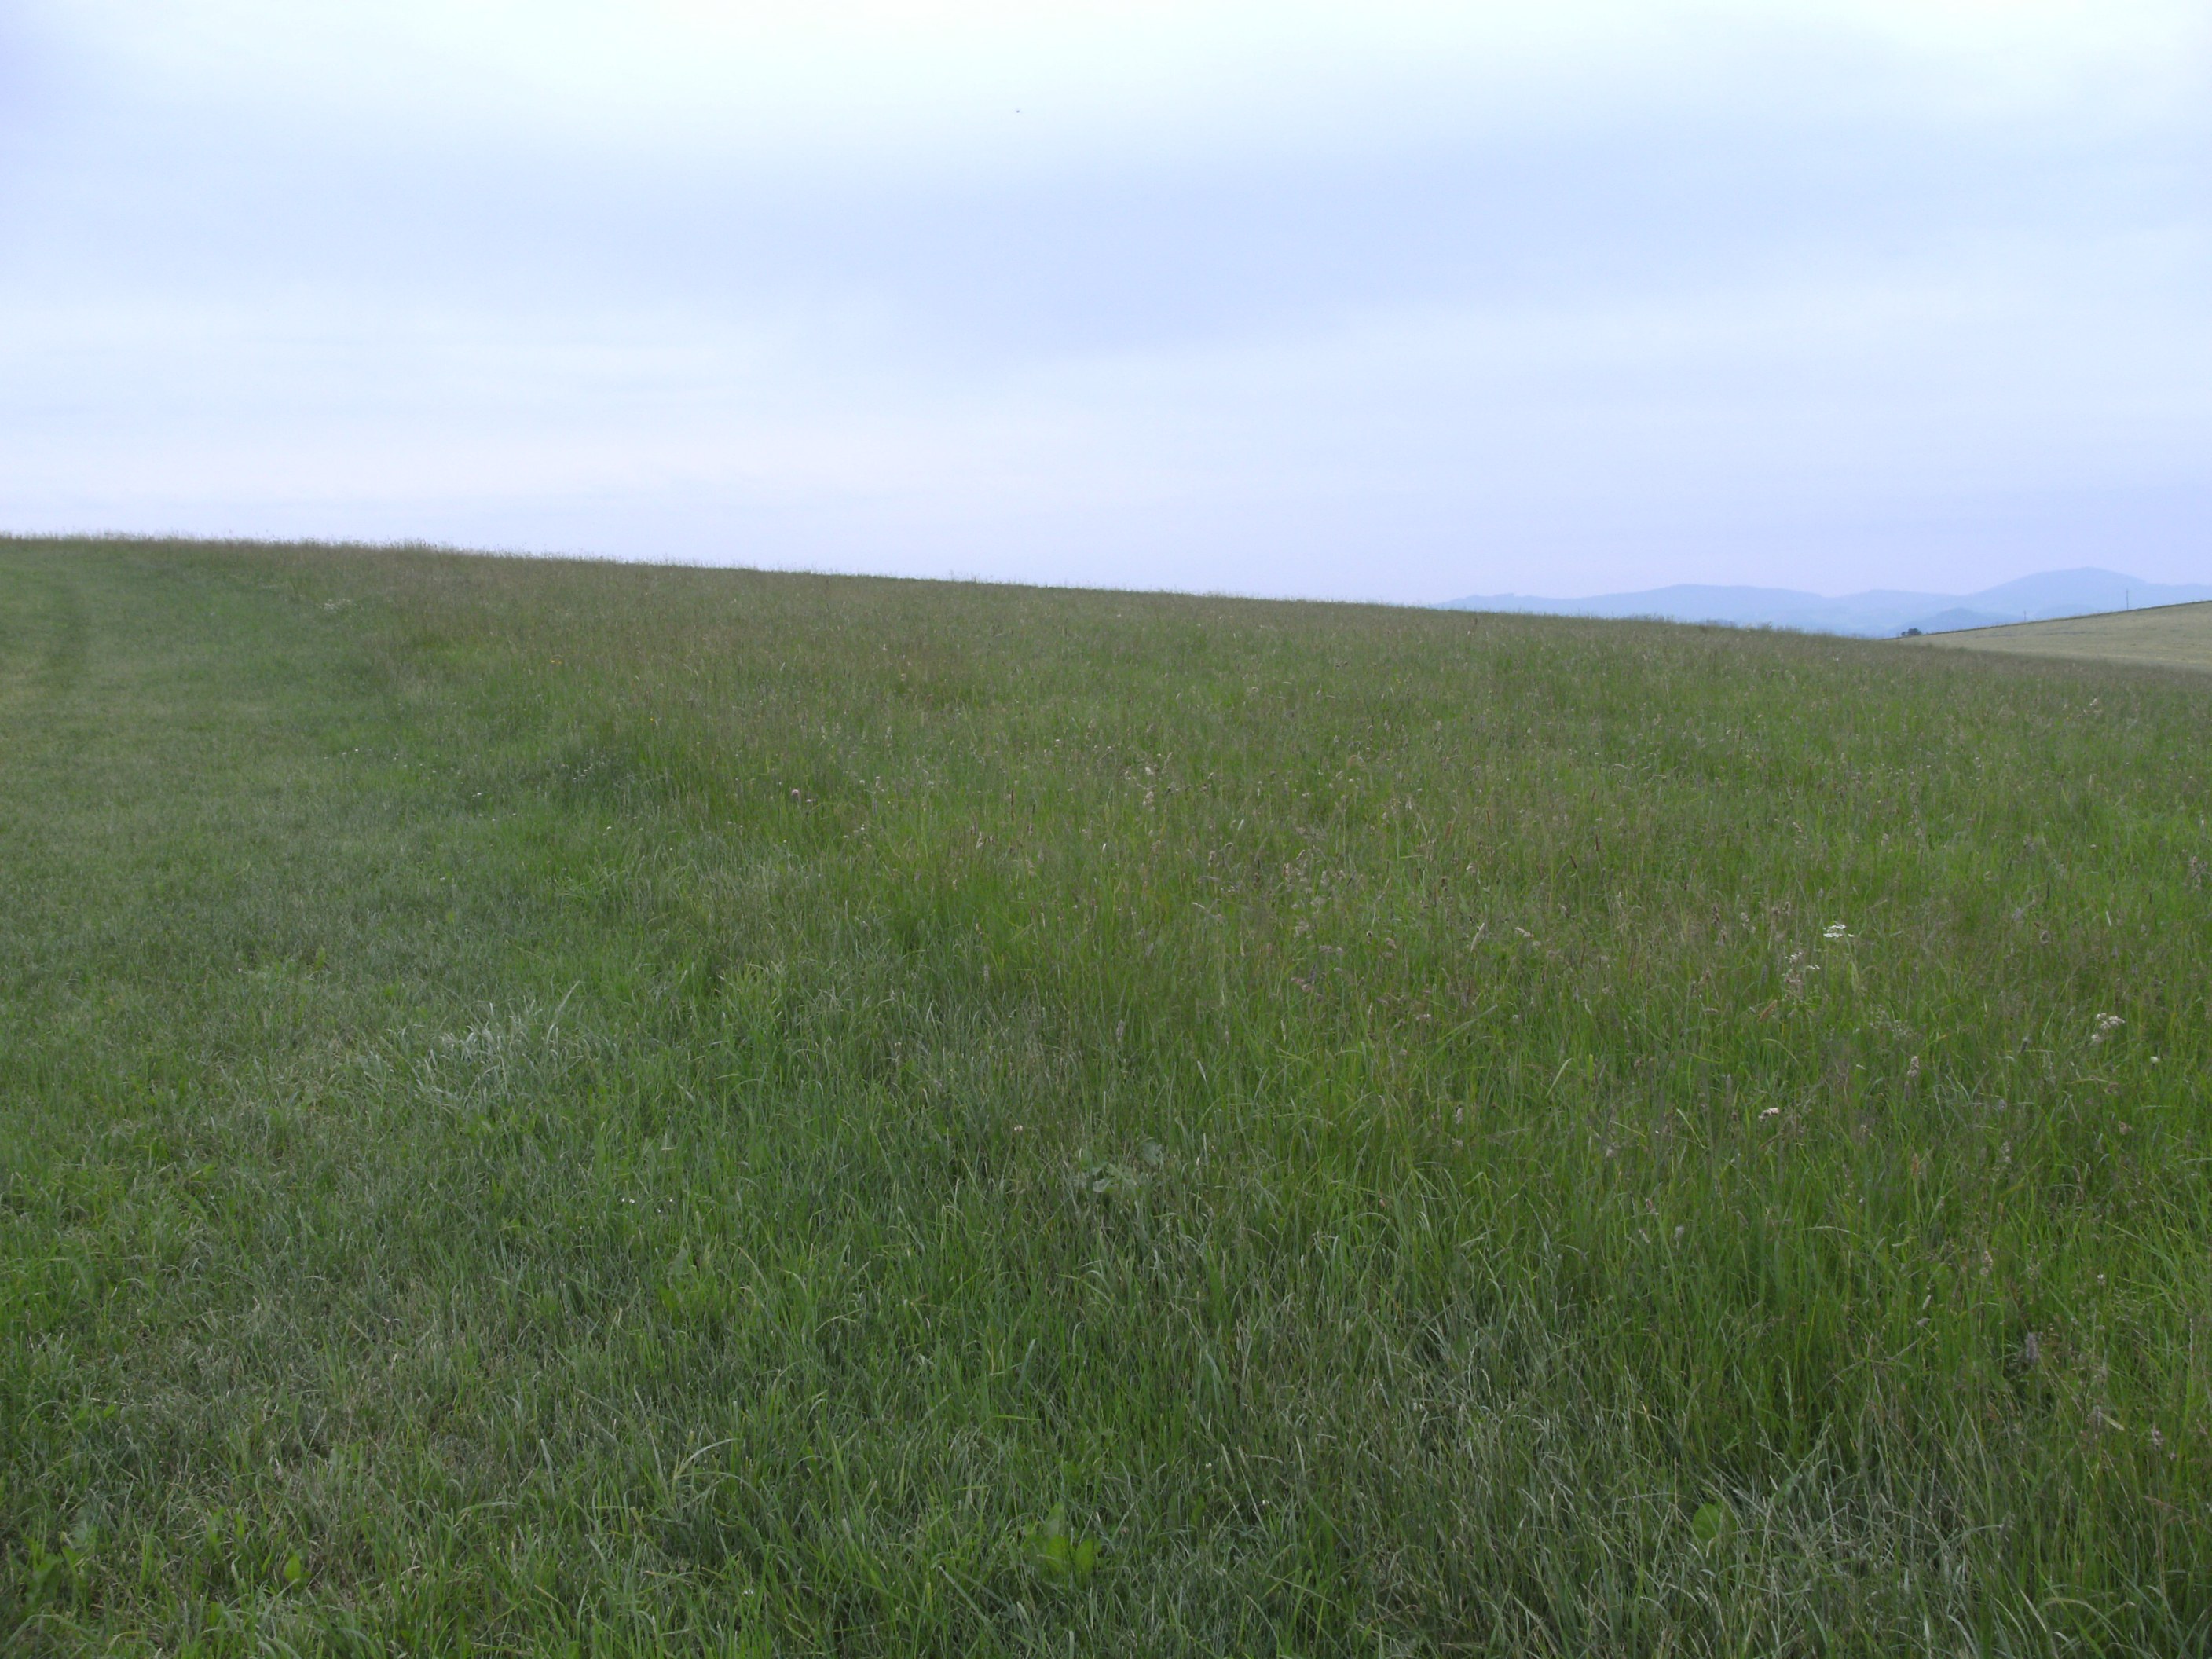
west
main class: Grassland
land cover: Grassland without tree/shrub cover
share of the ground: > 75 %
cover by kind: herbaceous plants 100 %
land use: Agriculture (excluding fallow land and kitchen gardens)
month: June
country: AT
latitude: 48.4737
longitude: 14.0445
